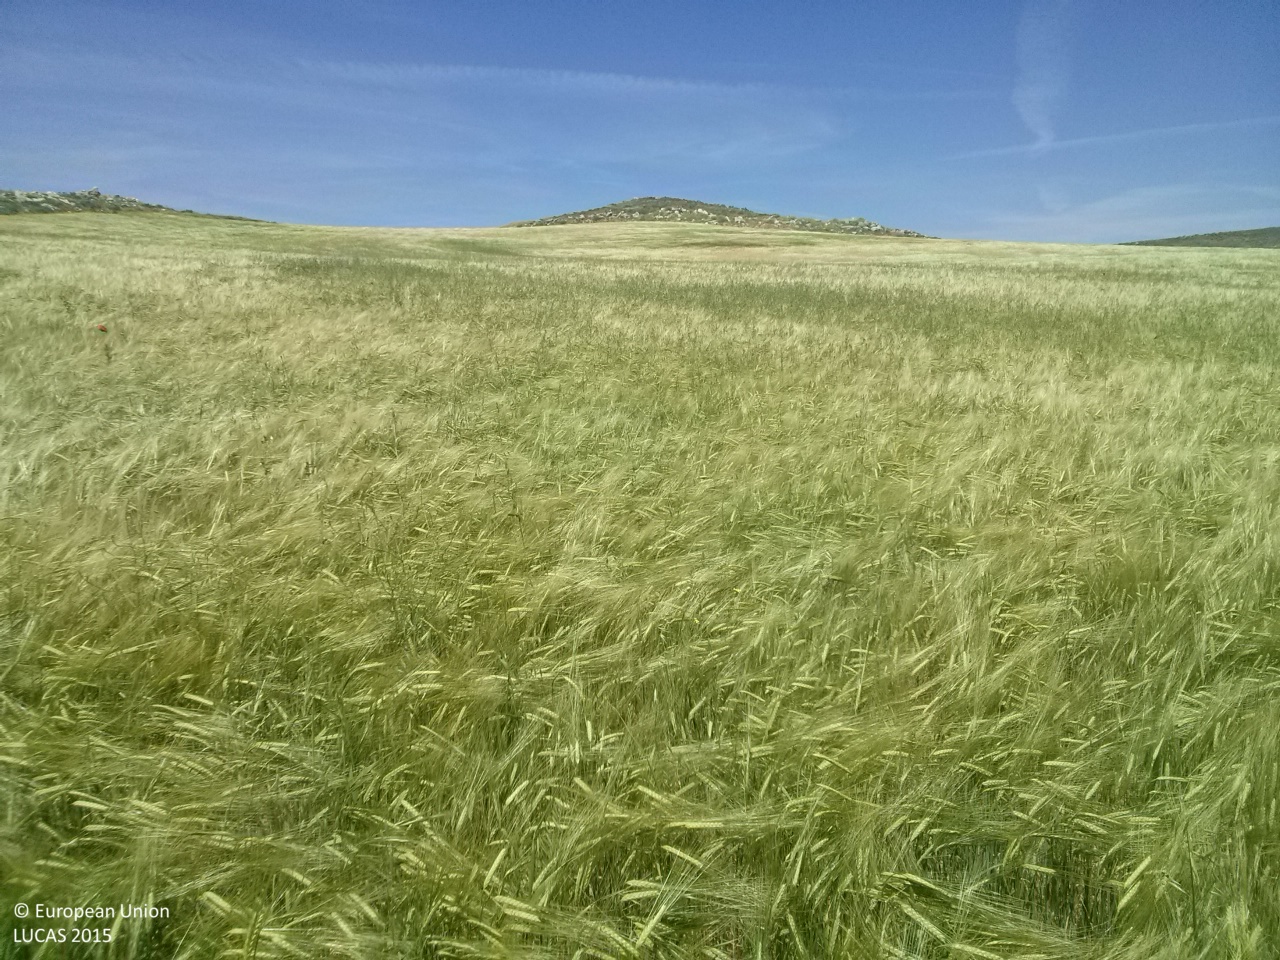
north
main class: Cropland
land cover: Barley
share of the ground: > 75 %
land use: Agriculture (excluding fallow land and kitchen gardens)
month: May
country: ES
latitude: 40.0075
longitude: -2.6837
